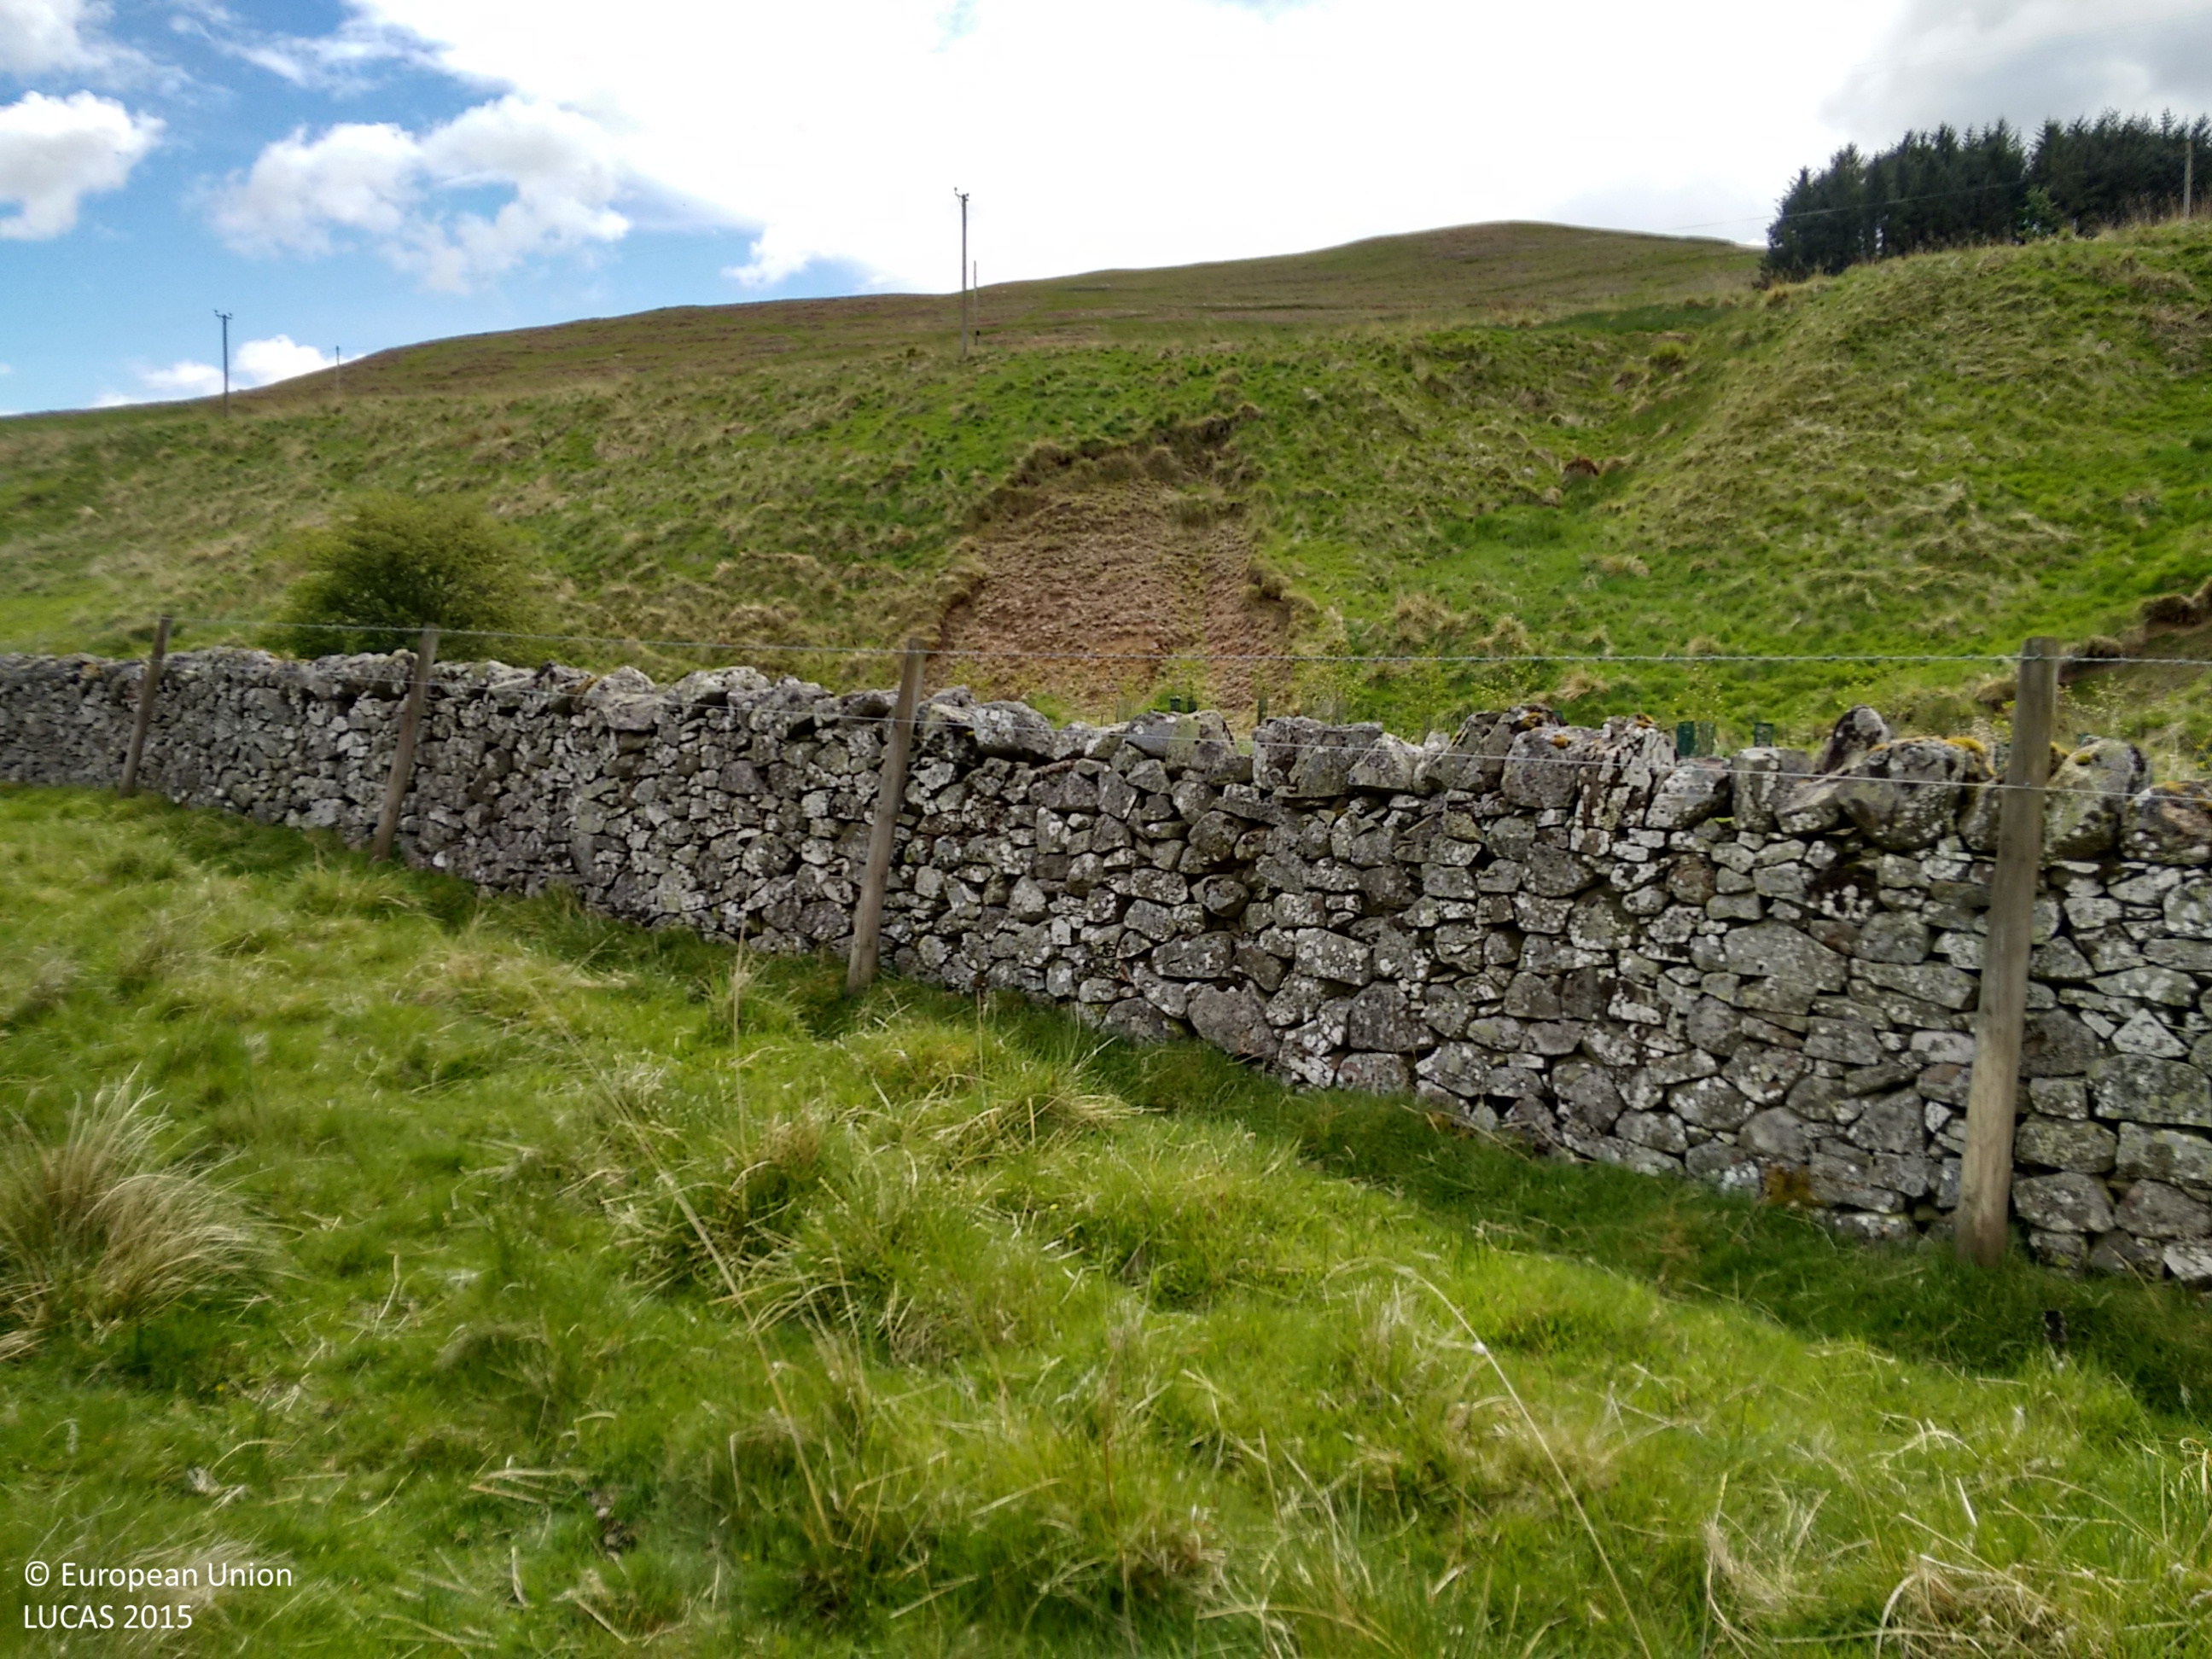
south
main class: Grassland
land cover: Grassland without tree/shrub cover
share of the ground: > 75 %
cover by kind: herbaceous plants 100 %
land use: Agriculture (excluding fallow land and kitchen gardens)
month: May
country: GB
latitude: 55.4612
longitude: -2.3470
